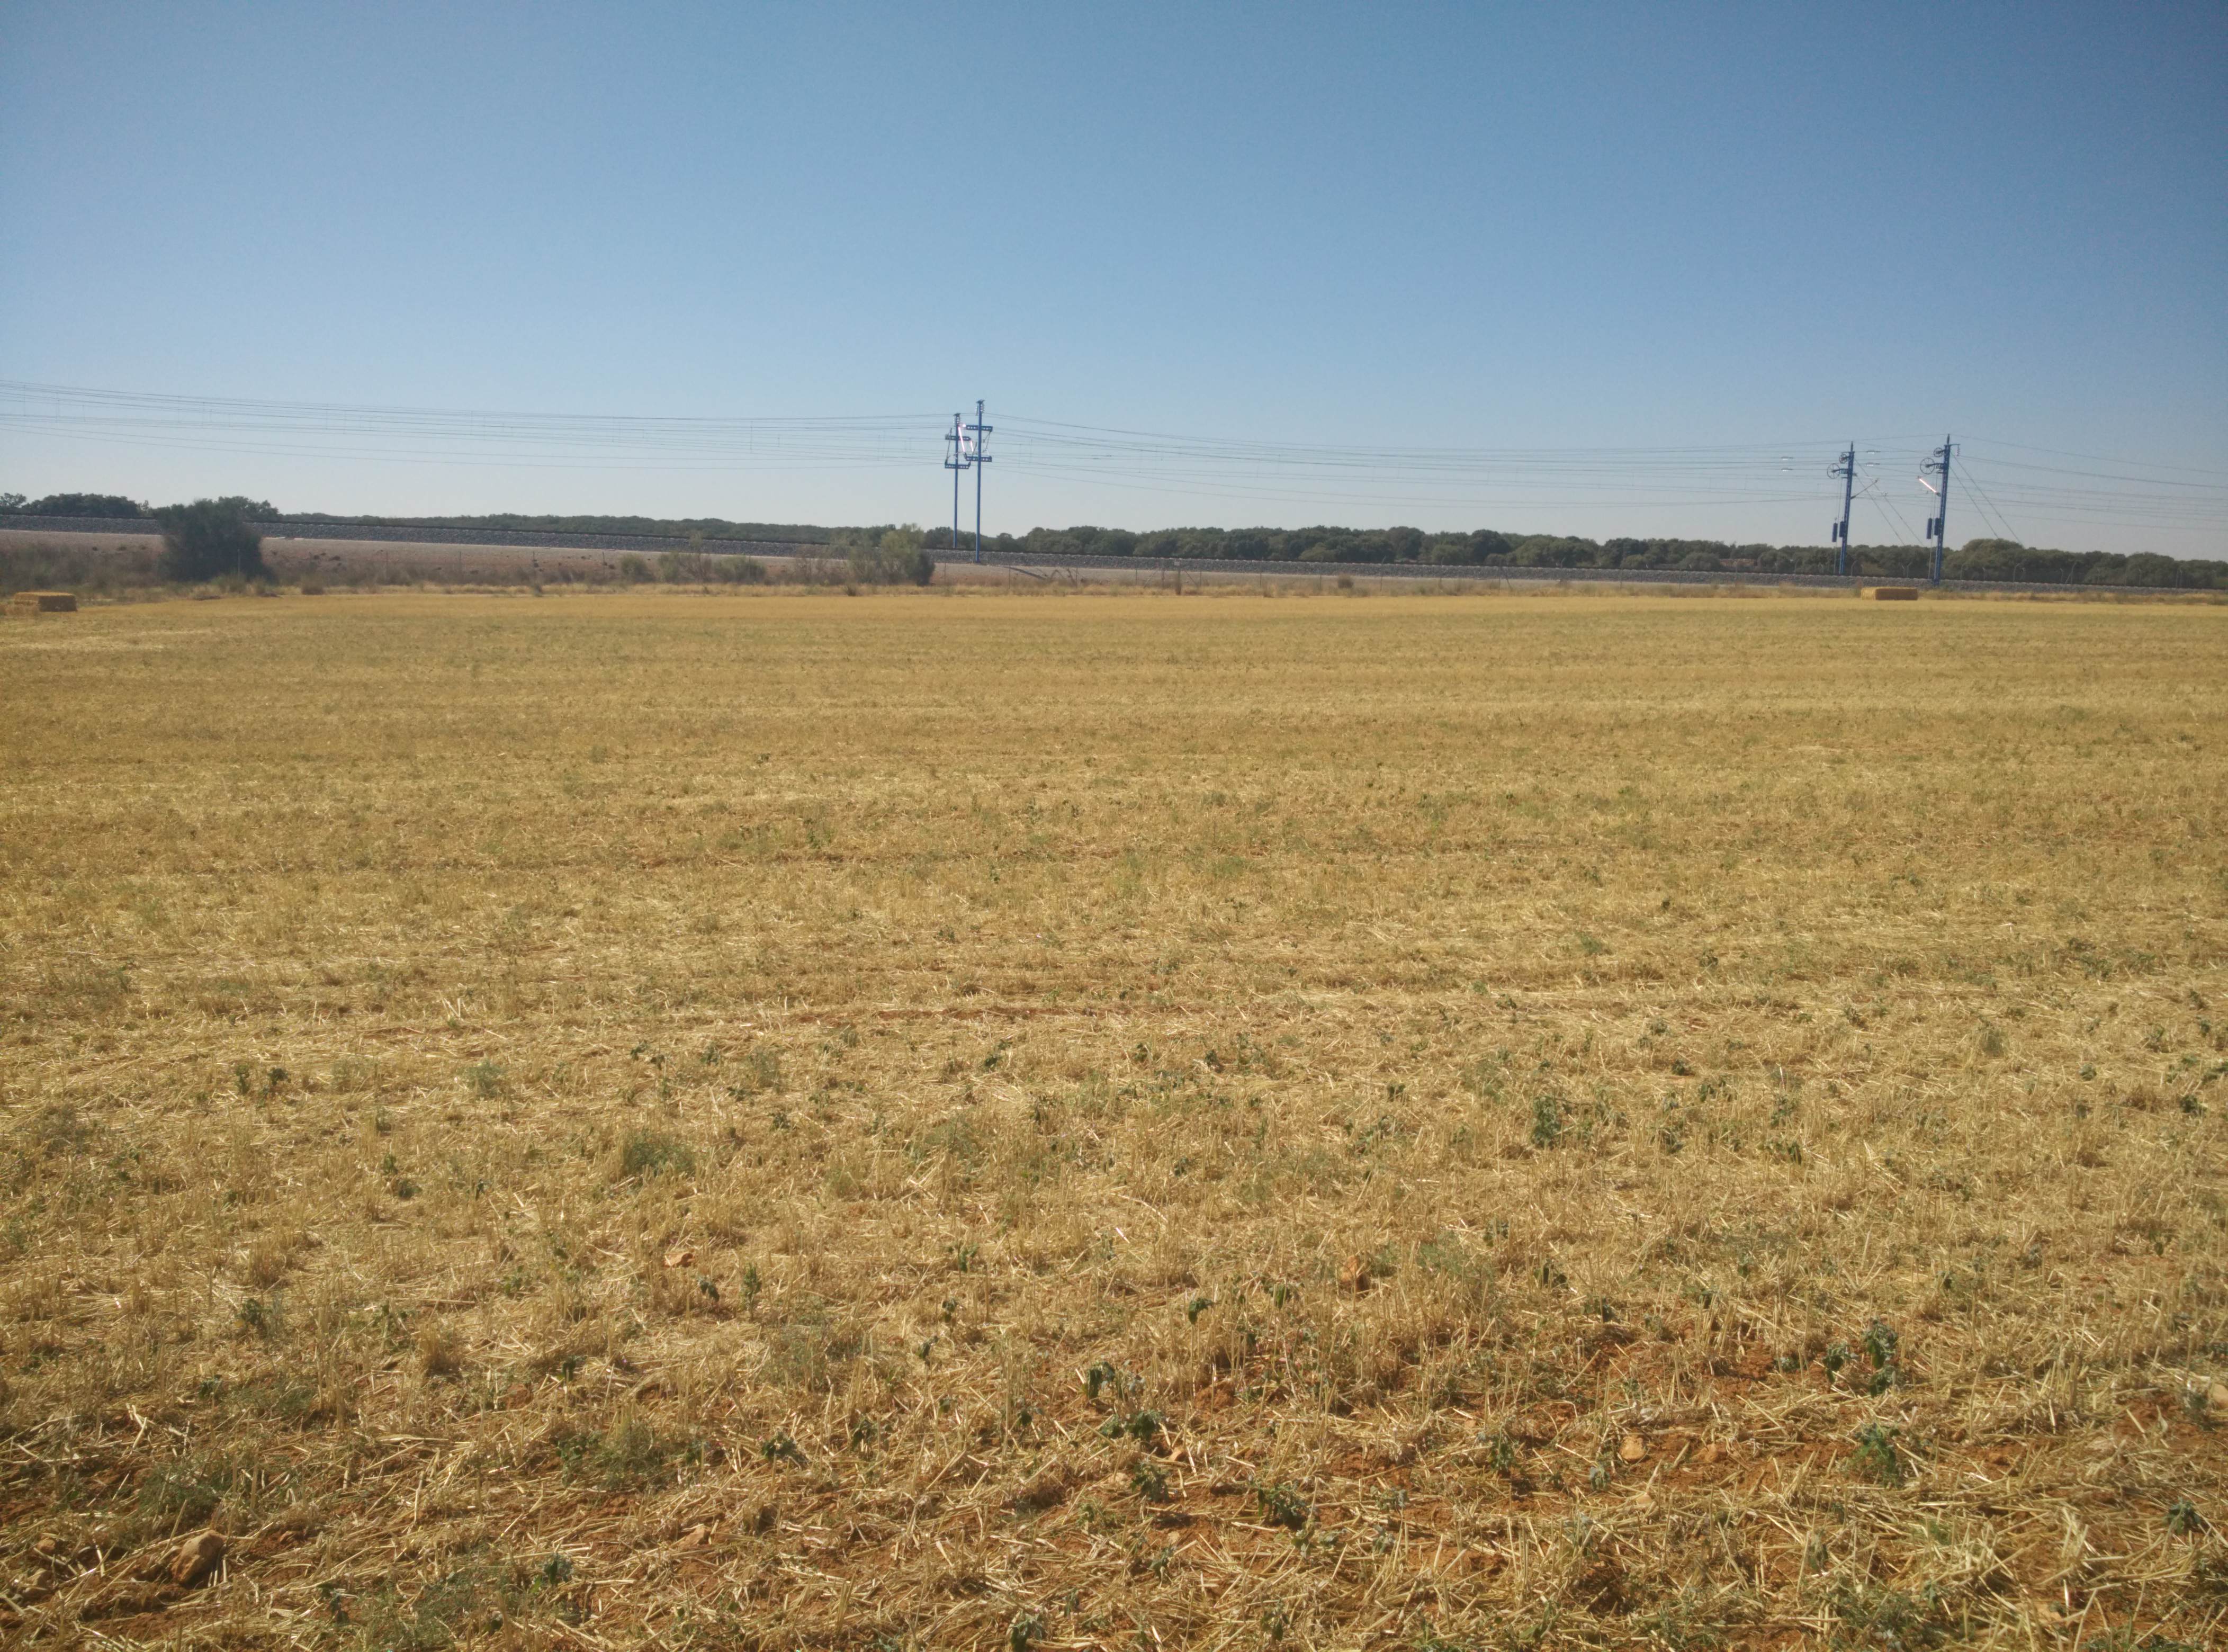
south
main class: Cropland
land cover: Barley
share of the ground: < 10 %
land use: Agriculture (excluding fallow land and kitchen gardens)
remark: Harvested field
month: July
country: ES
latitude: 40.8446
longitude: -2.8536
